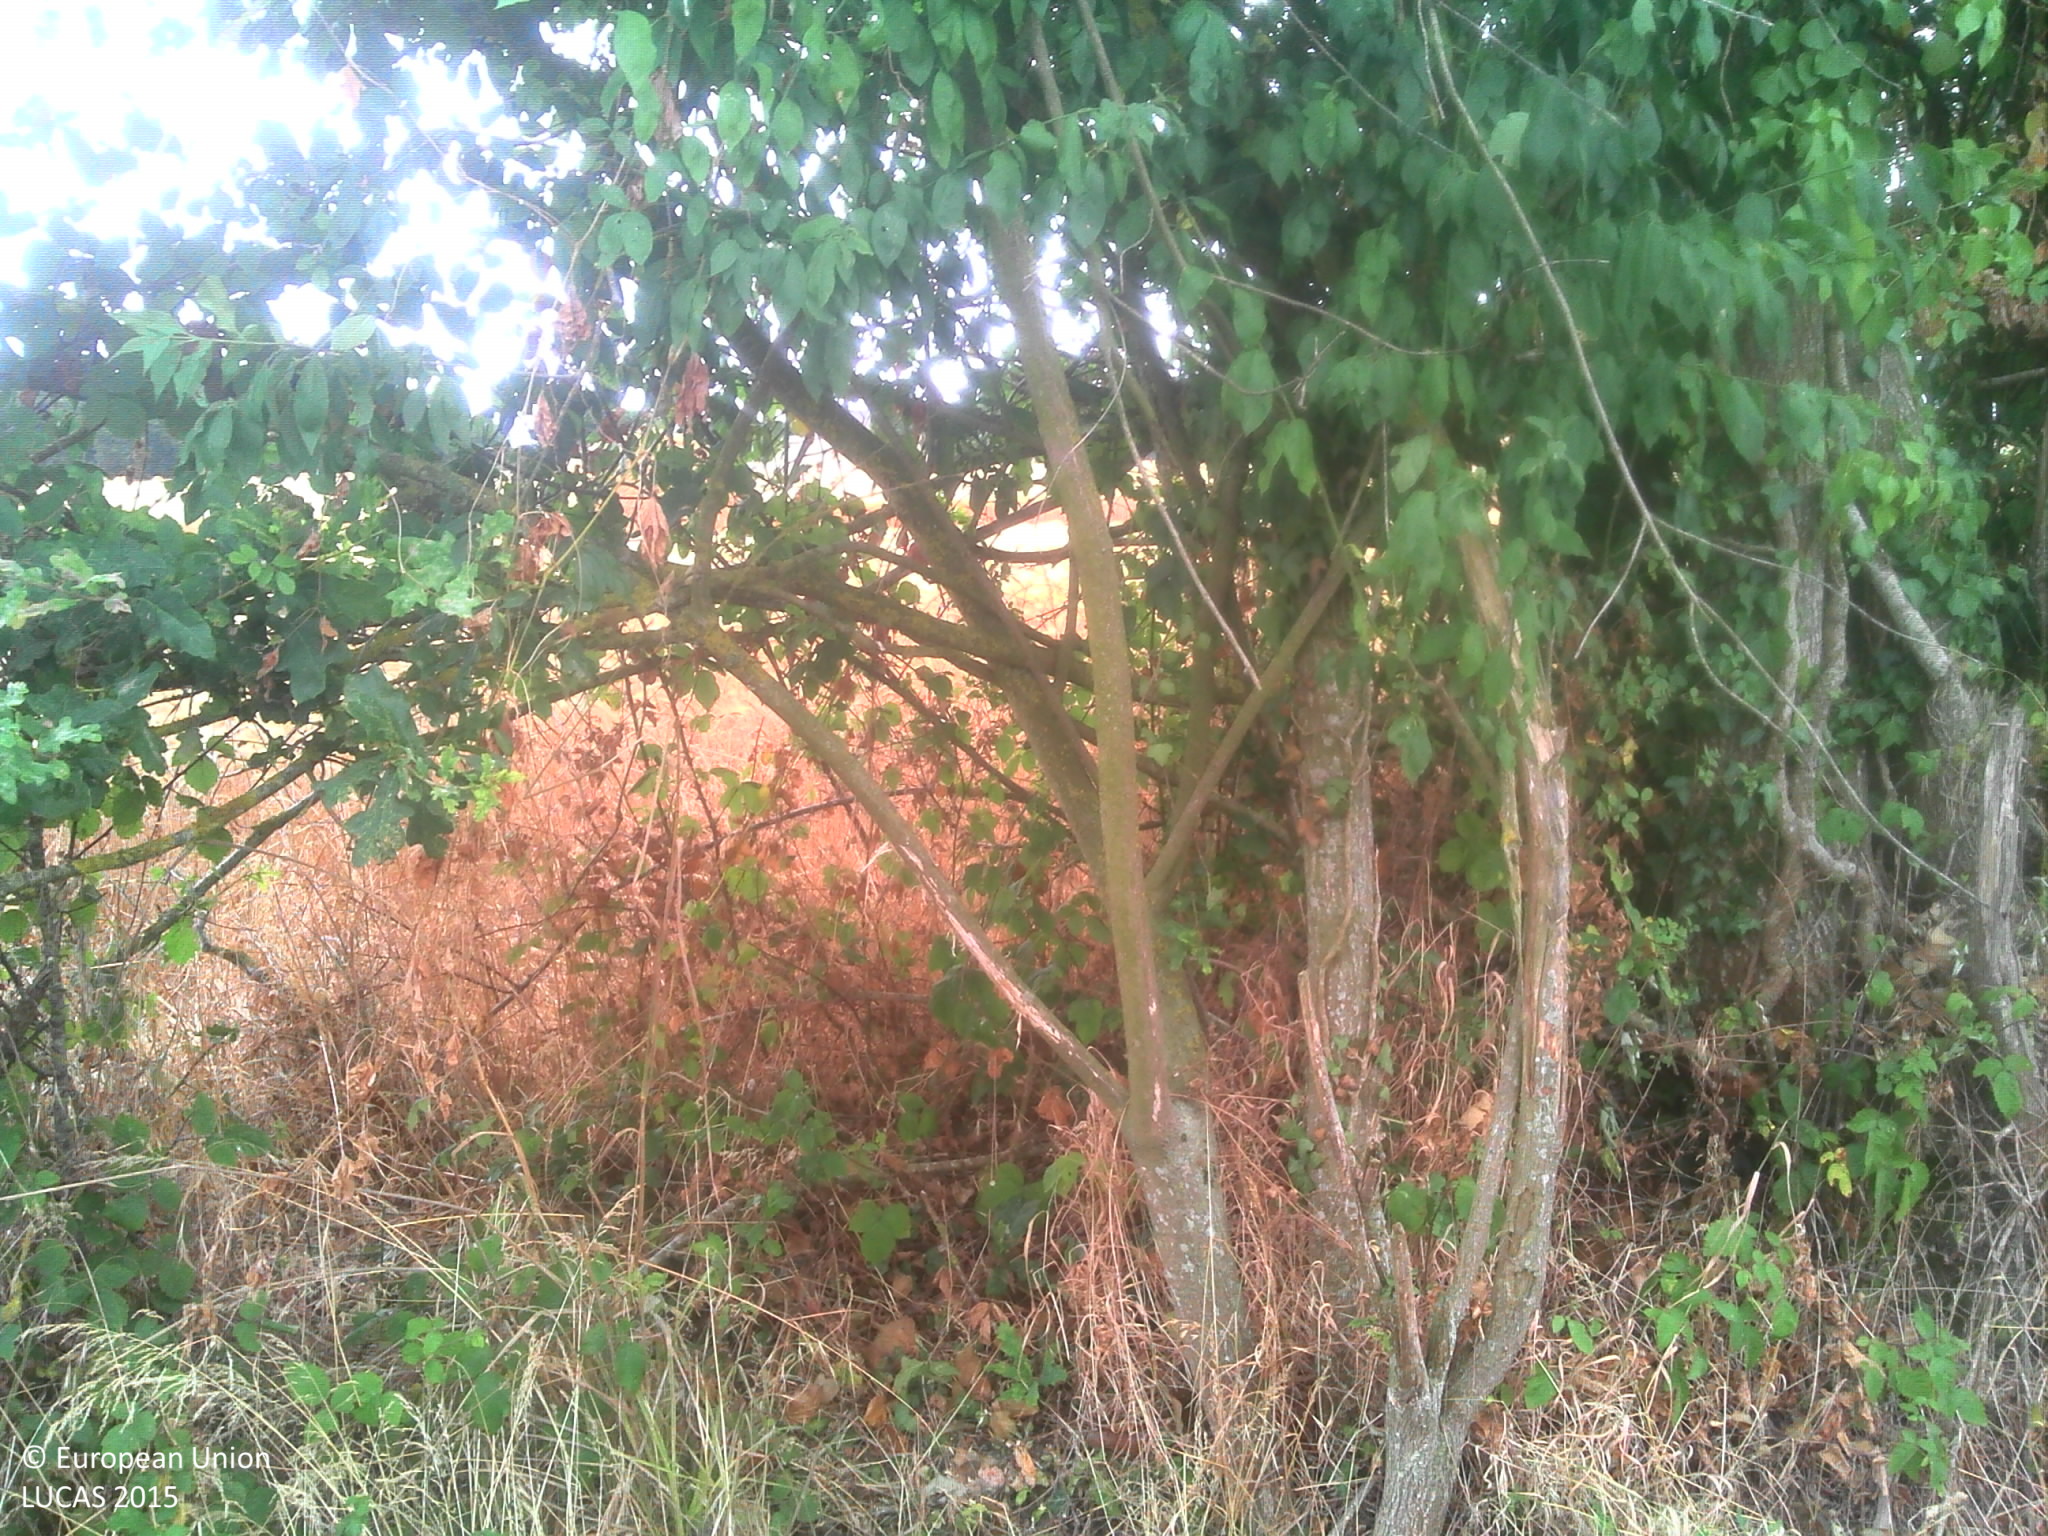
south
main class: Cropland
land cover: Rape and turnip rape
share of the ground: > 75 %
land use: Agriculture (excluding fallow land and kitchen gardens)
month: July
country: FR
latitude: 47.9338
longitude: 1.0803
